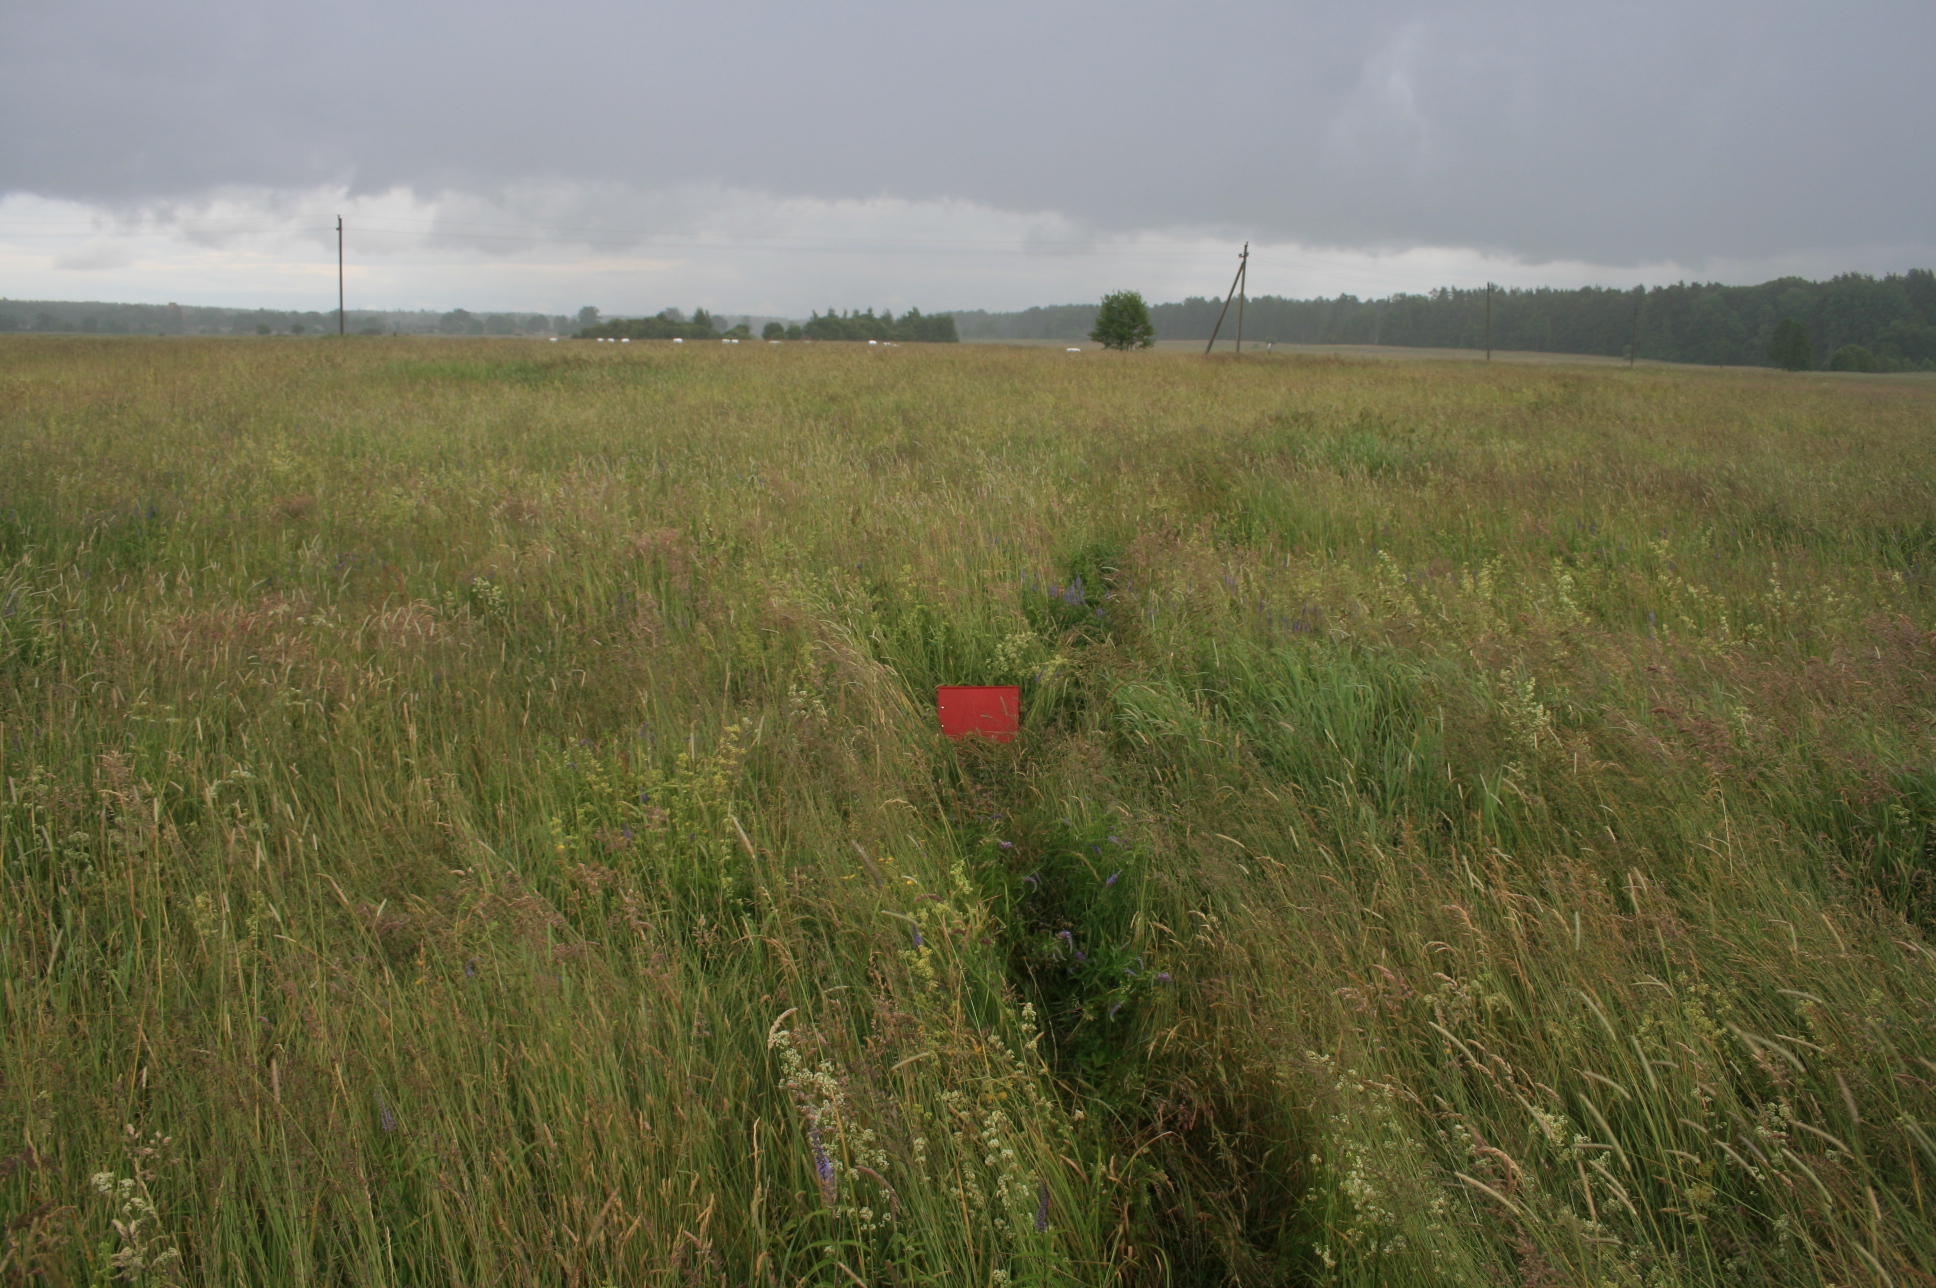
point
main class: Grassland
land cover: Grassland without tree/shrub cover
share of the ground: > 75 %
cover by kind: herbaceous plants 100 %
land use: Agriculture (excluding fallow land and kitchen gardens)
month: June
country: LT
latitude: 55.1078
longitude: 22.2375
